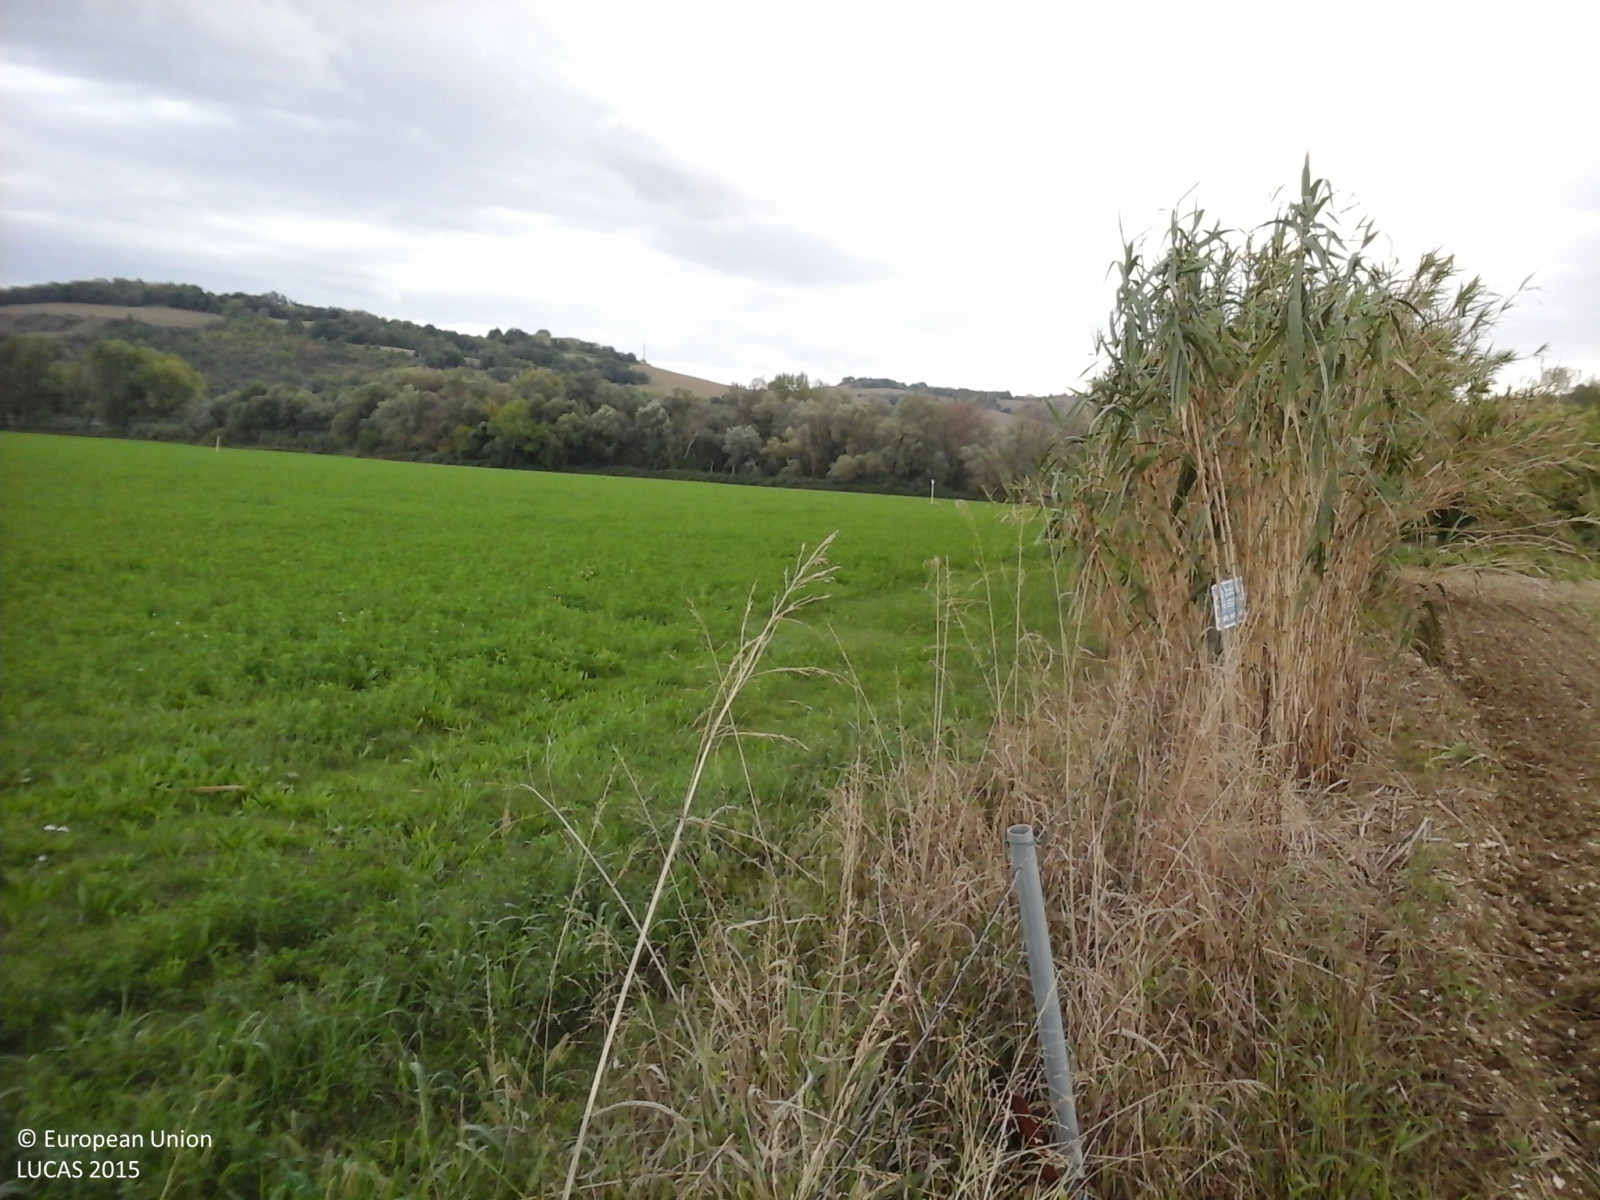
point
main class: Cropland
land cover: Lucerne
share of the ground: > 75 %
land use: Agriculture (excluding fallow land and kitchen gardens)
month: October
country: IT
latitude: 43.5227
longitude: 13.2706
